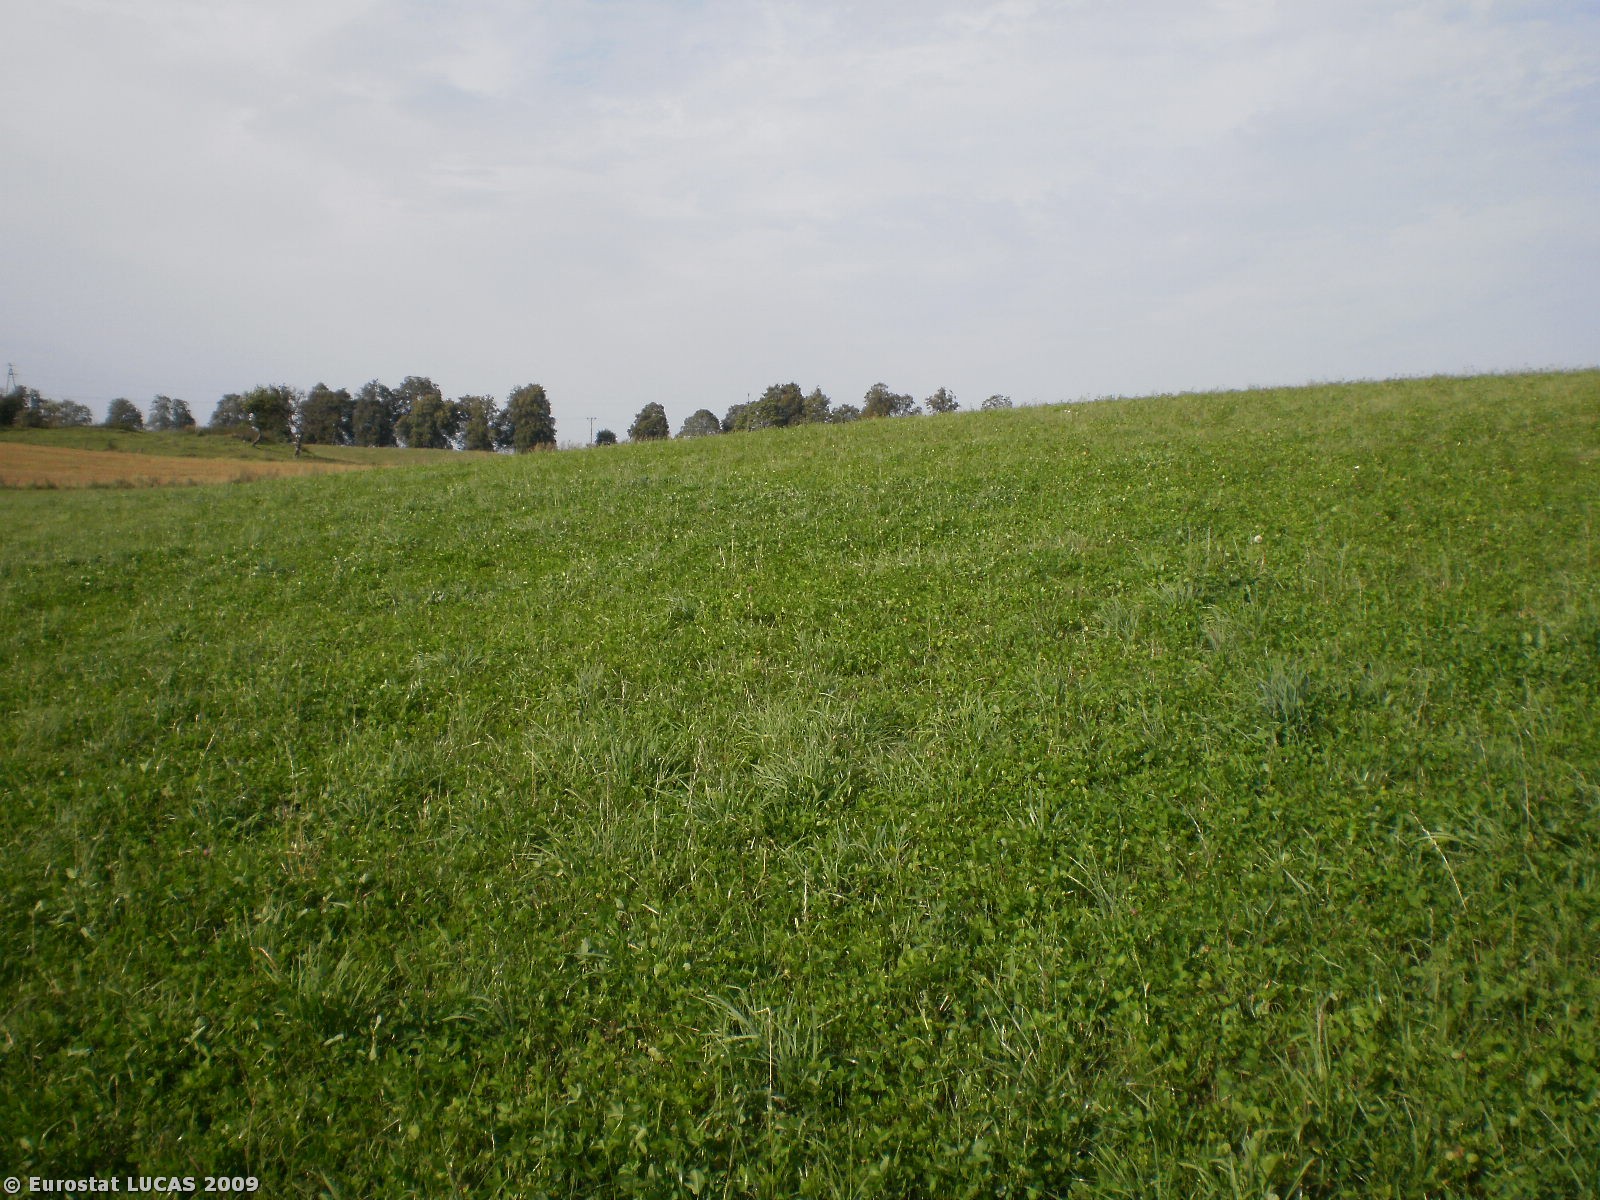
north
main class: Grassland
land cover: Grassland without tree/shrub cover
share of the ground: > 75 %
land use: Agriculture (excluding fallow land and kitchen gardens)
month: September
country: PL
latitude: 53.6725
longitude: 21.0790
